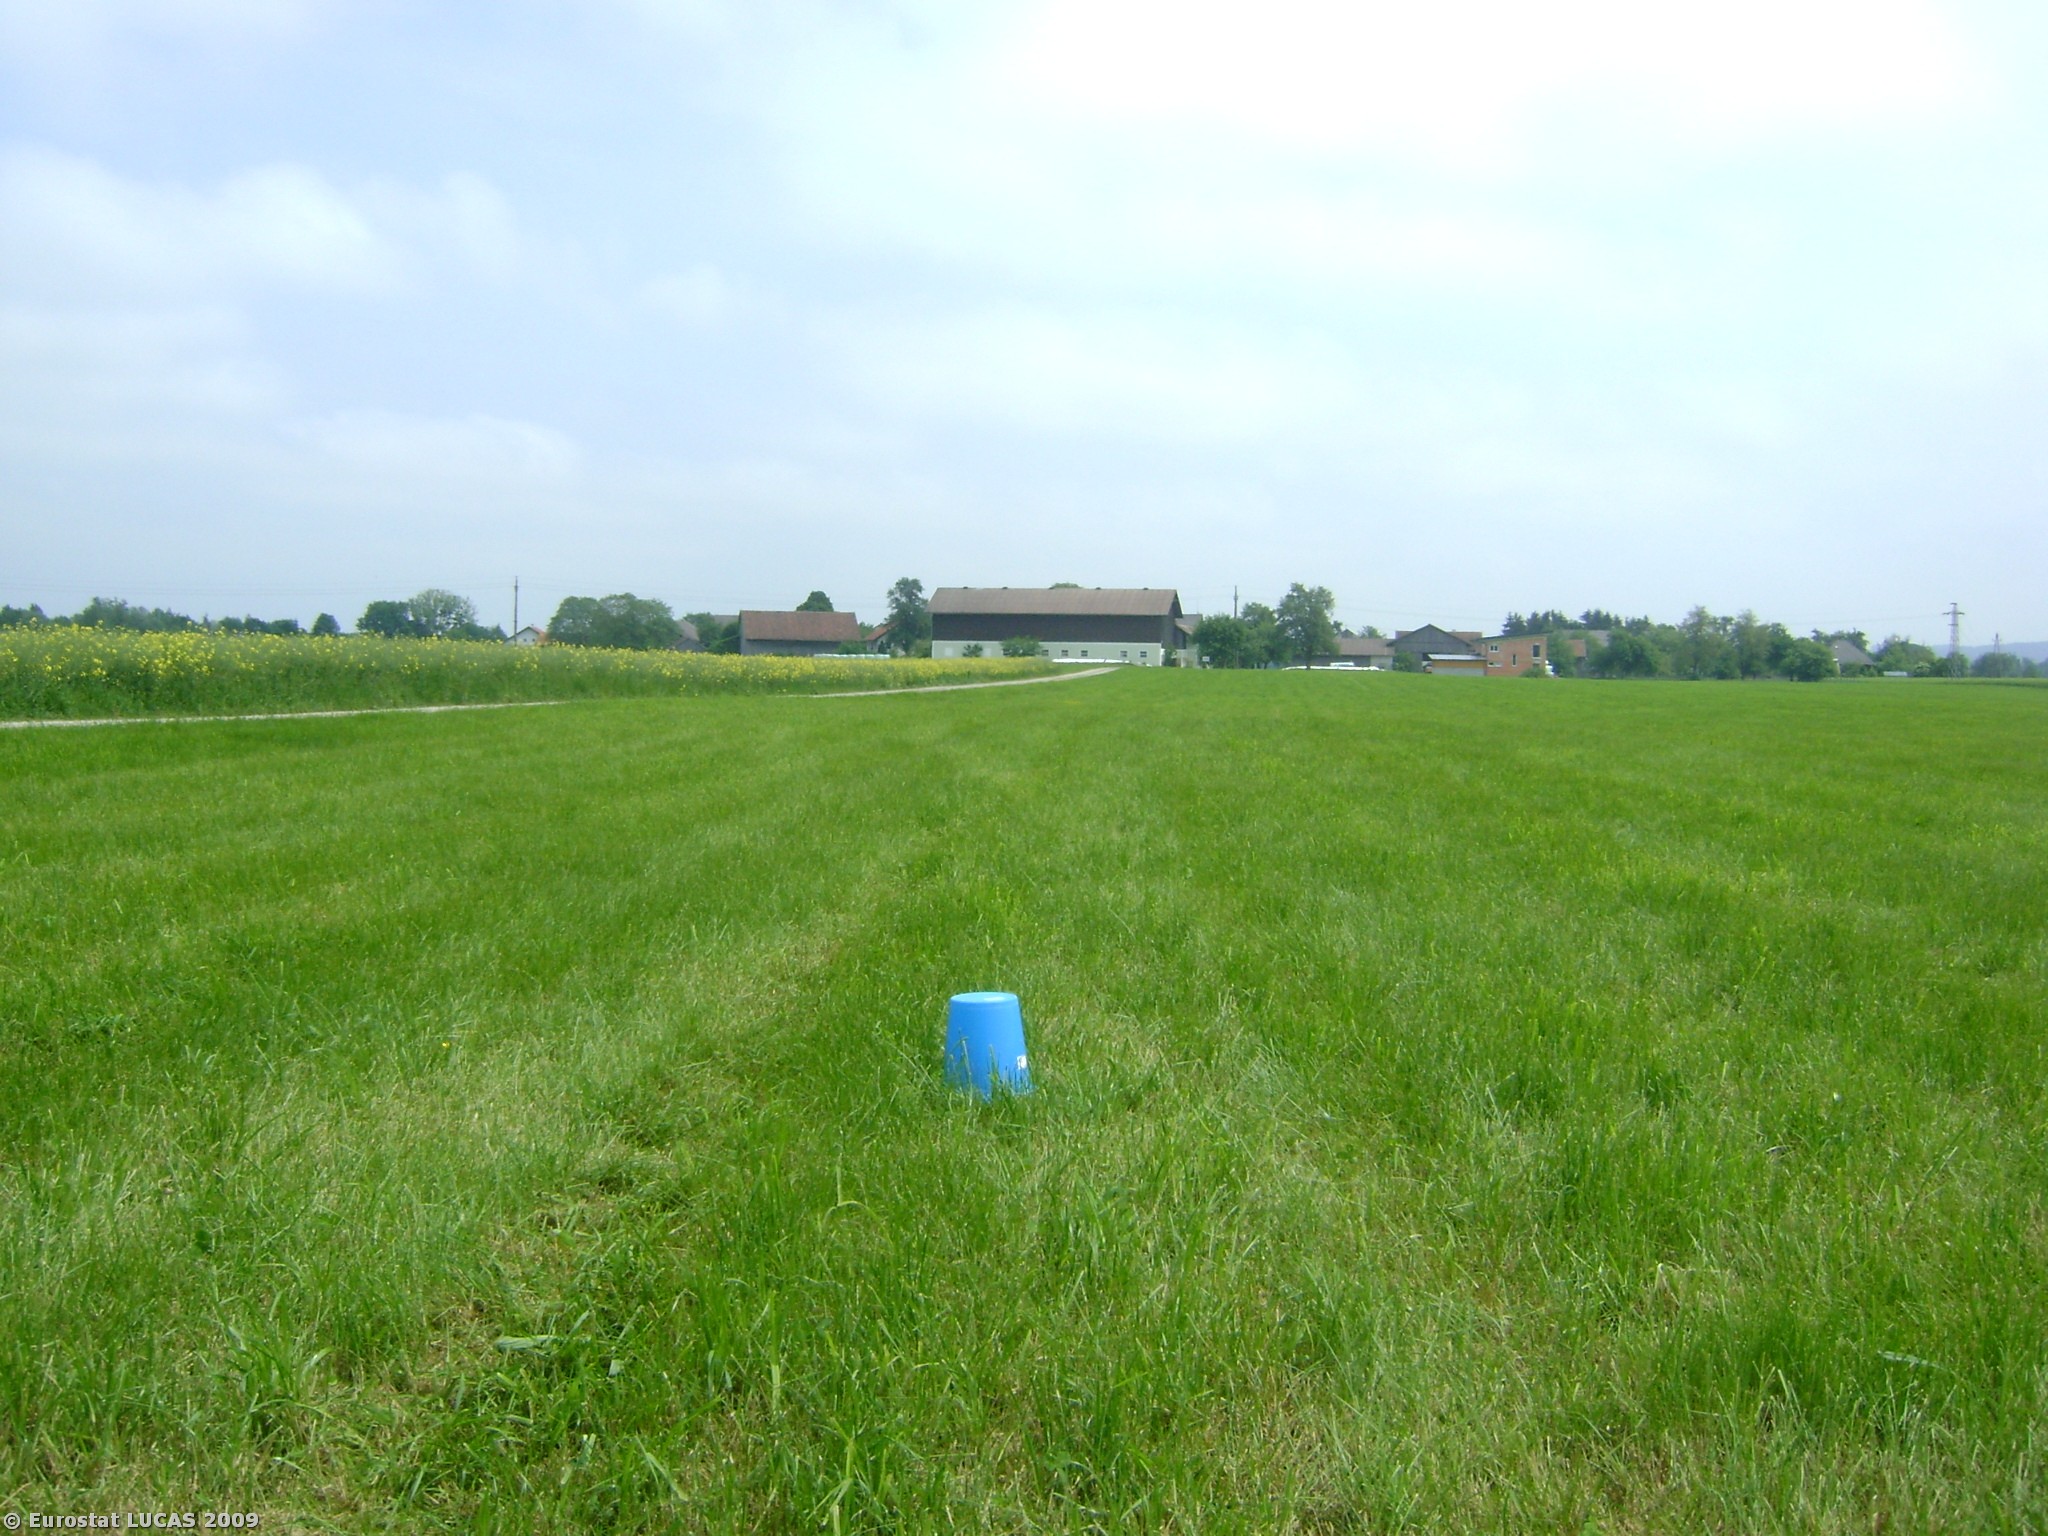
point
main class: Grassland
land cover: Grassland without tree/shrub cover
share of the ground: > 75 %
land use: Agriculture (excluding fallow land and kitchen gardens)
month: May
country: AT
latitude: 48.2674
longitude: 13.1921
